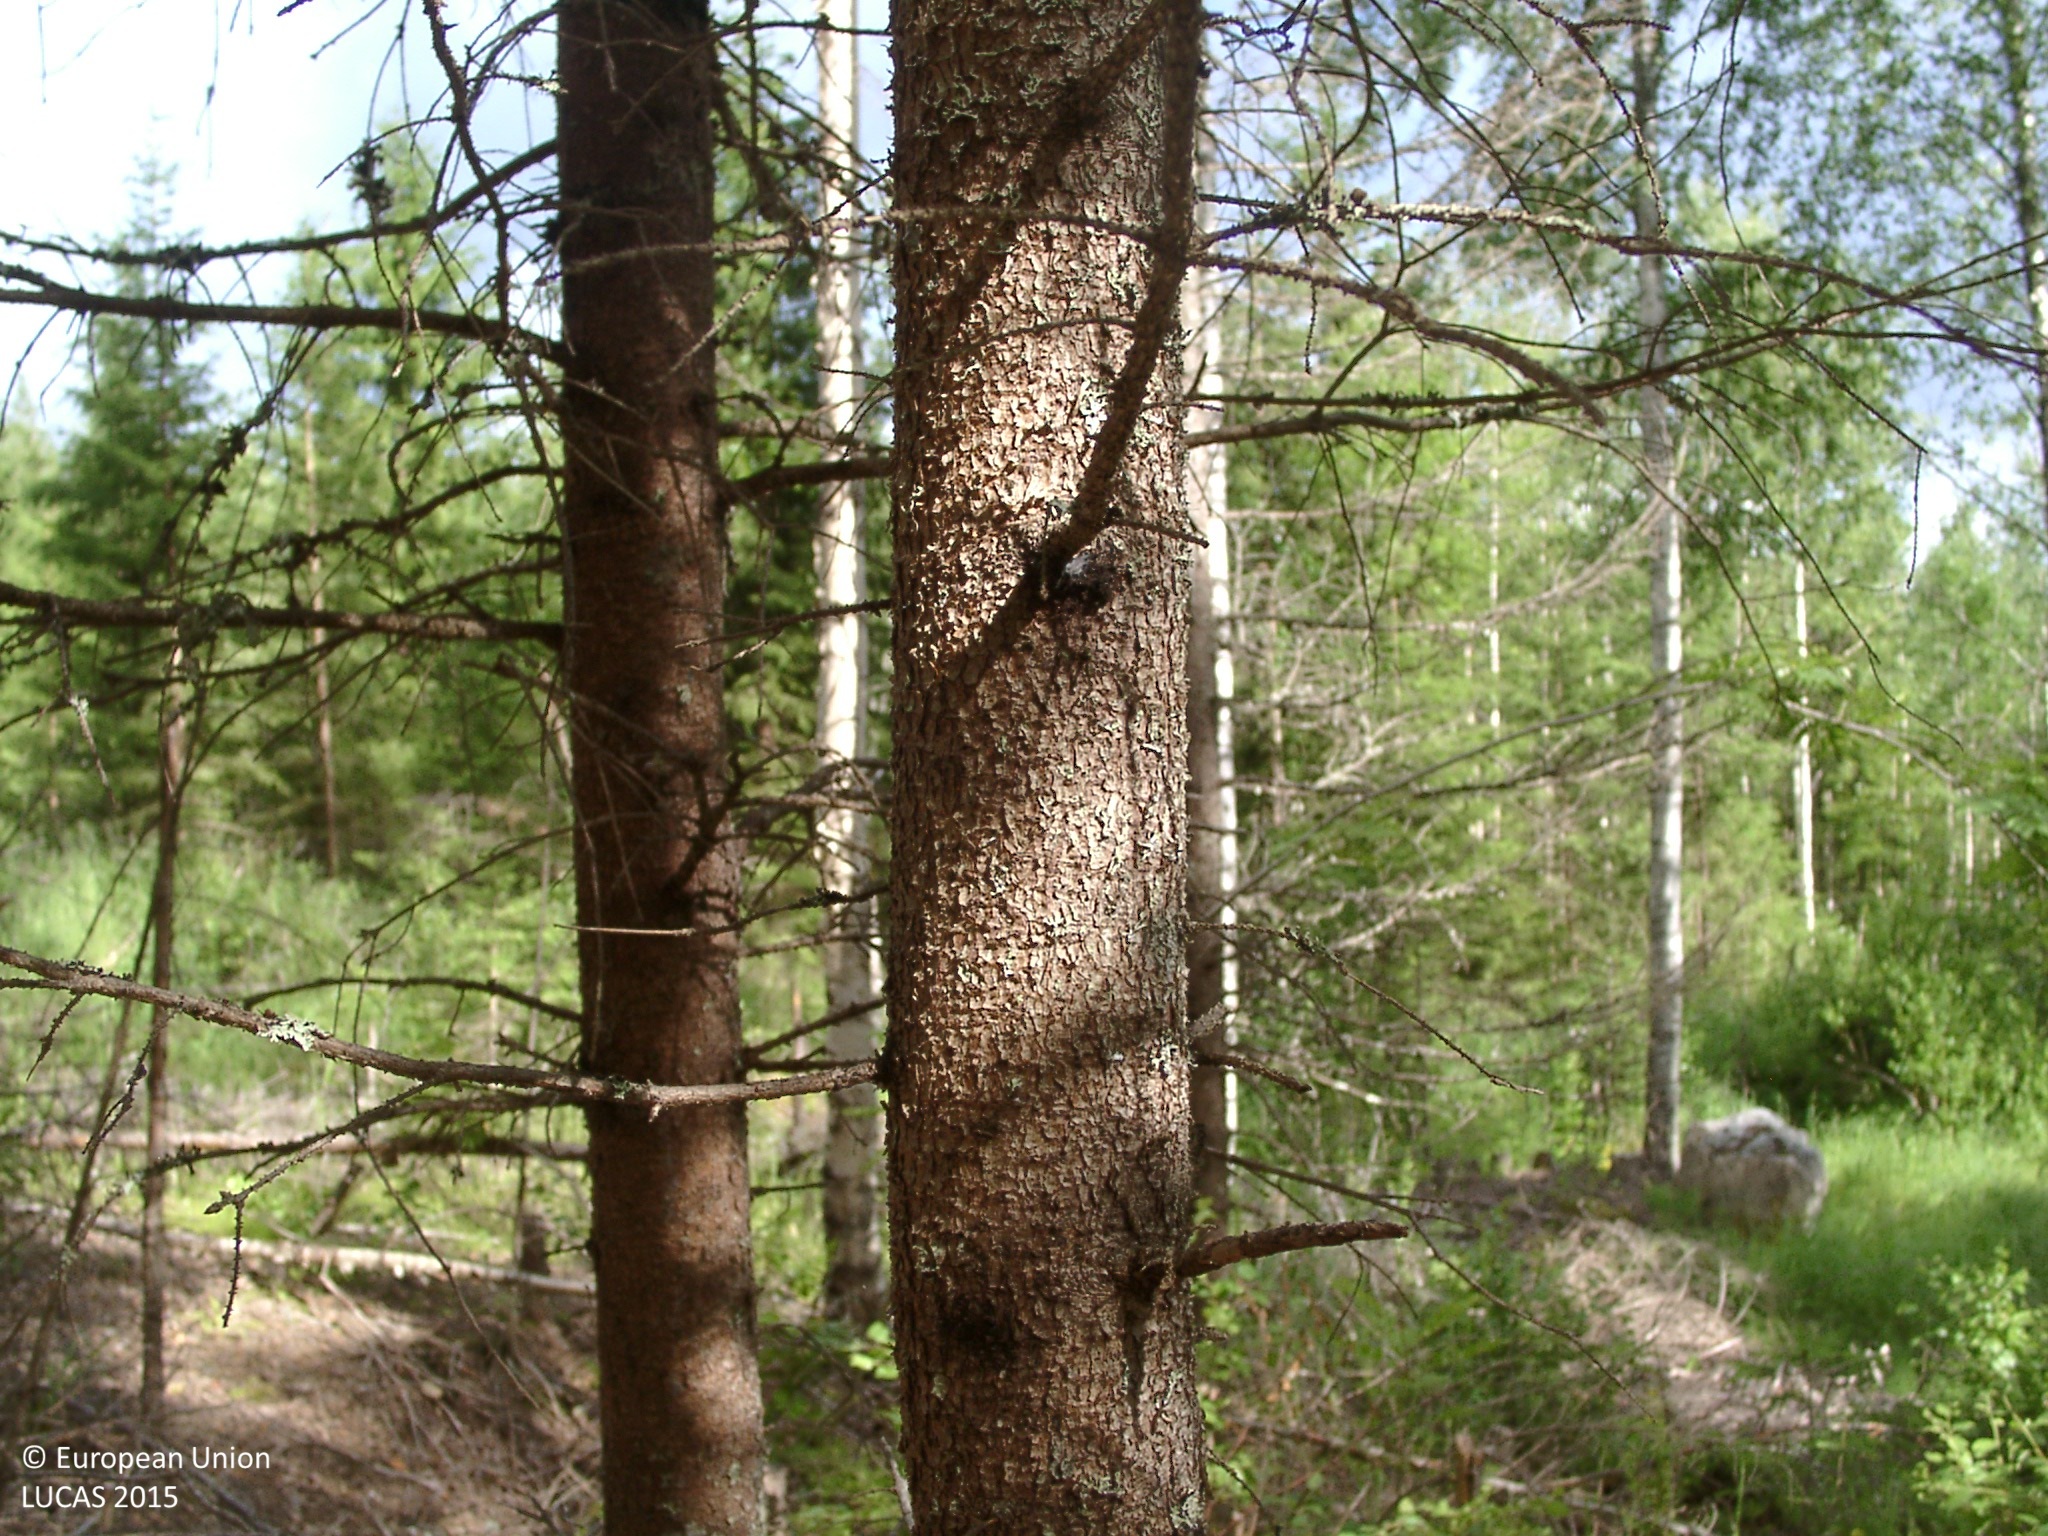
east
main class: Woodland
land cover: Other coniferous woodland
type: boreal forest
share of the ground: > 75 %
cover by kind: coniferous forest trees 70 %, broadleaved forest trees 5 %, unconsolidated bare surface 5 %
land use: Forestry
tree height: > 5 m
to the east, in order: Other coniferous woodland; Spruce dominated mixed woodland; Rivers and streams; Spruce dominated coniferous woodland; Other mixed woodland; Ditches and canals; Spruce dominated mixed woodland; Grass margins; Tracks; Shruby margins; Ditches and canals; Pine dominated mixed woodland; Other mixed woodland; Shruby margins; Other mixed woodland; Pine dominated coniferous woodland; Other coniferous woodland
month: July
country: FI
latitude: 62.2106
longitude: 25.1217
